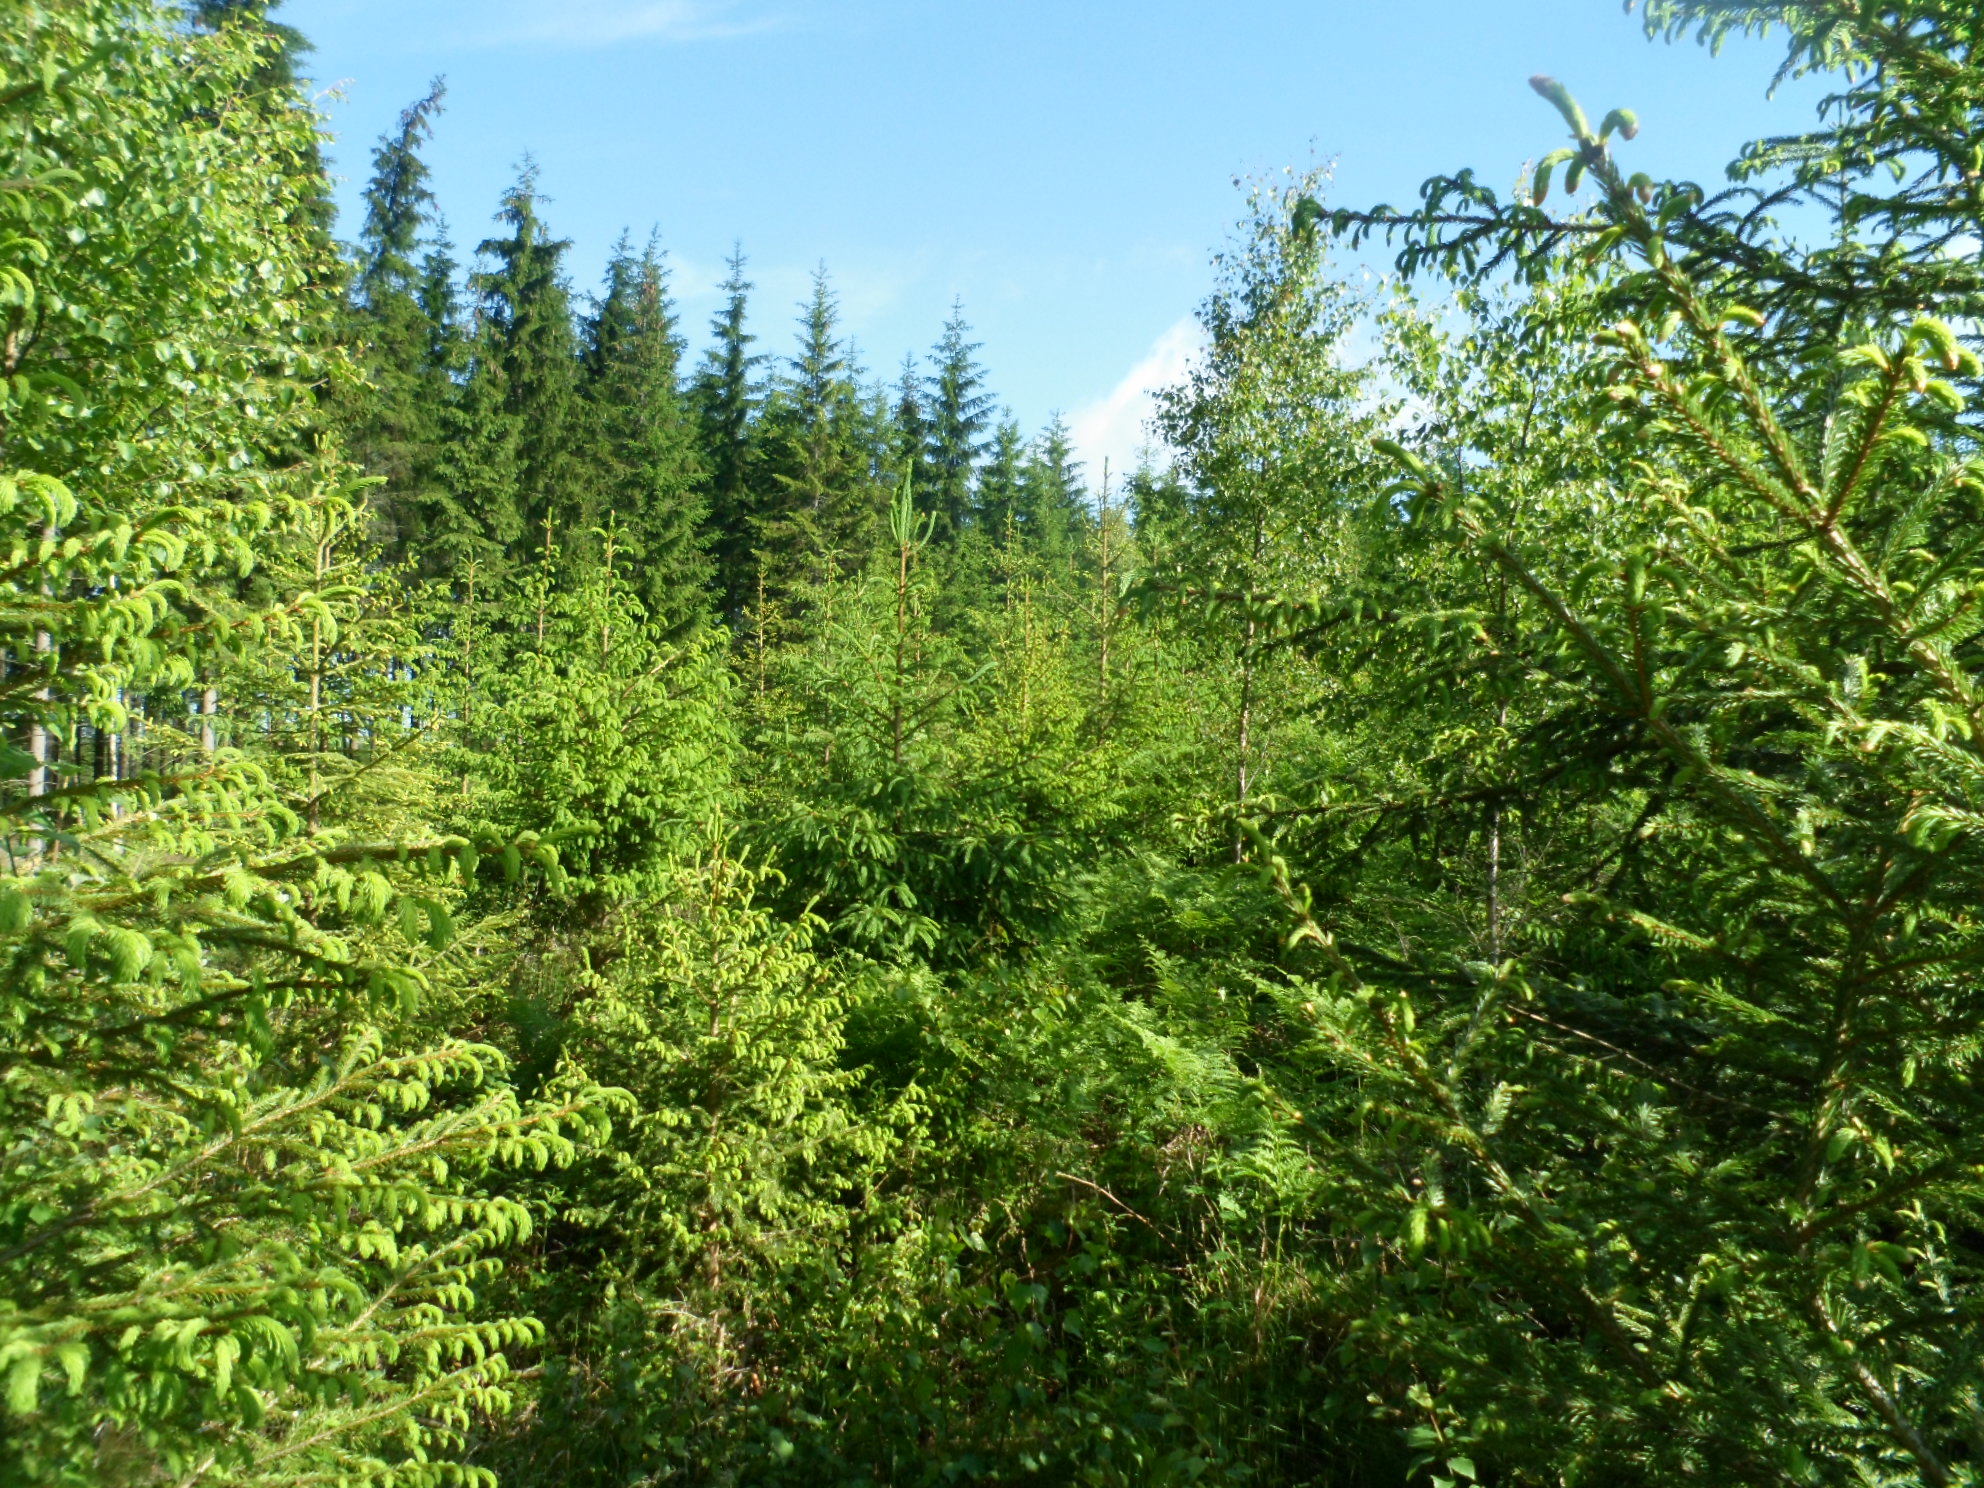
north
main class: Woodland
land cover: Spruce dominated mixed woodland
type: boreal forest
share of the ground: 50 - 75 %
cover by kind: coniferous forest trees 30 %, herbaceous plants 25 %, broadleaved forest trees 20 %, shrubs 20 %, lichens and mosses 5 %
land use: Forestry
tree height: < 5 m
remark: Clear cut
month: June
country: SE
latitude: 57.0852
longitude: 14.8975
